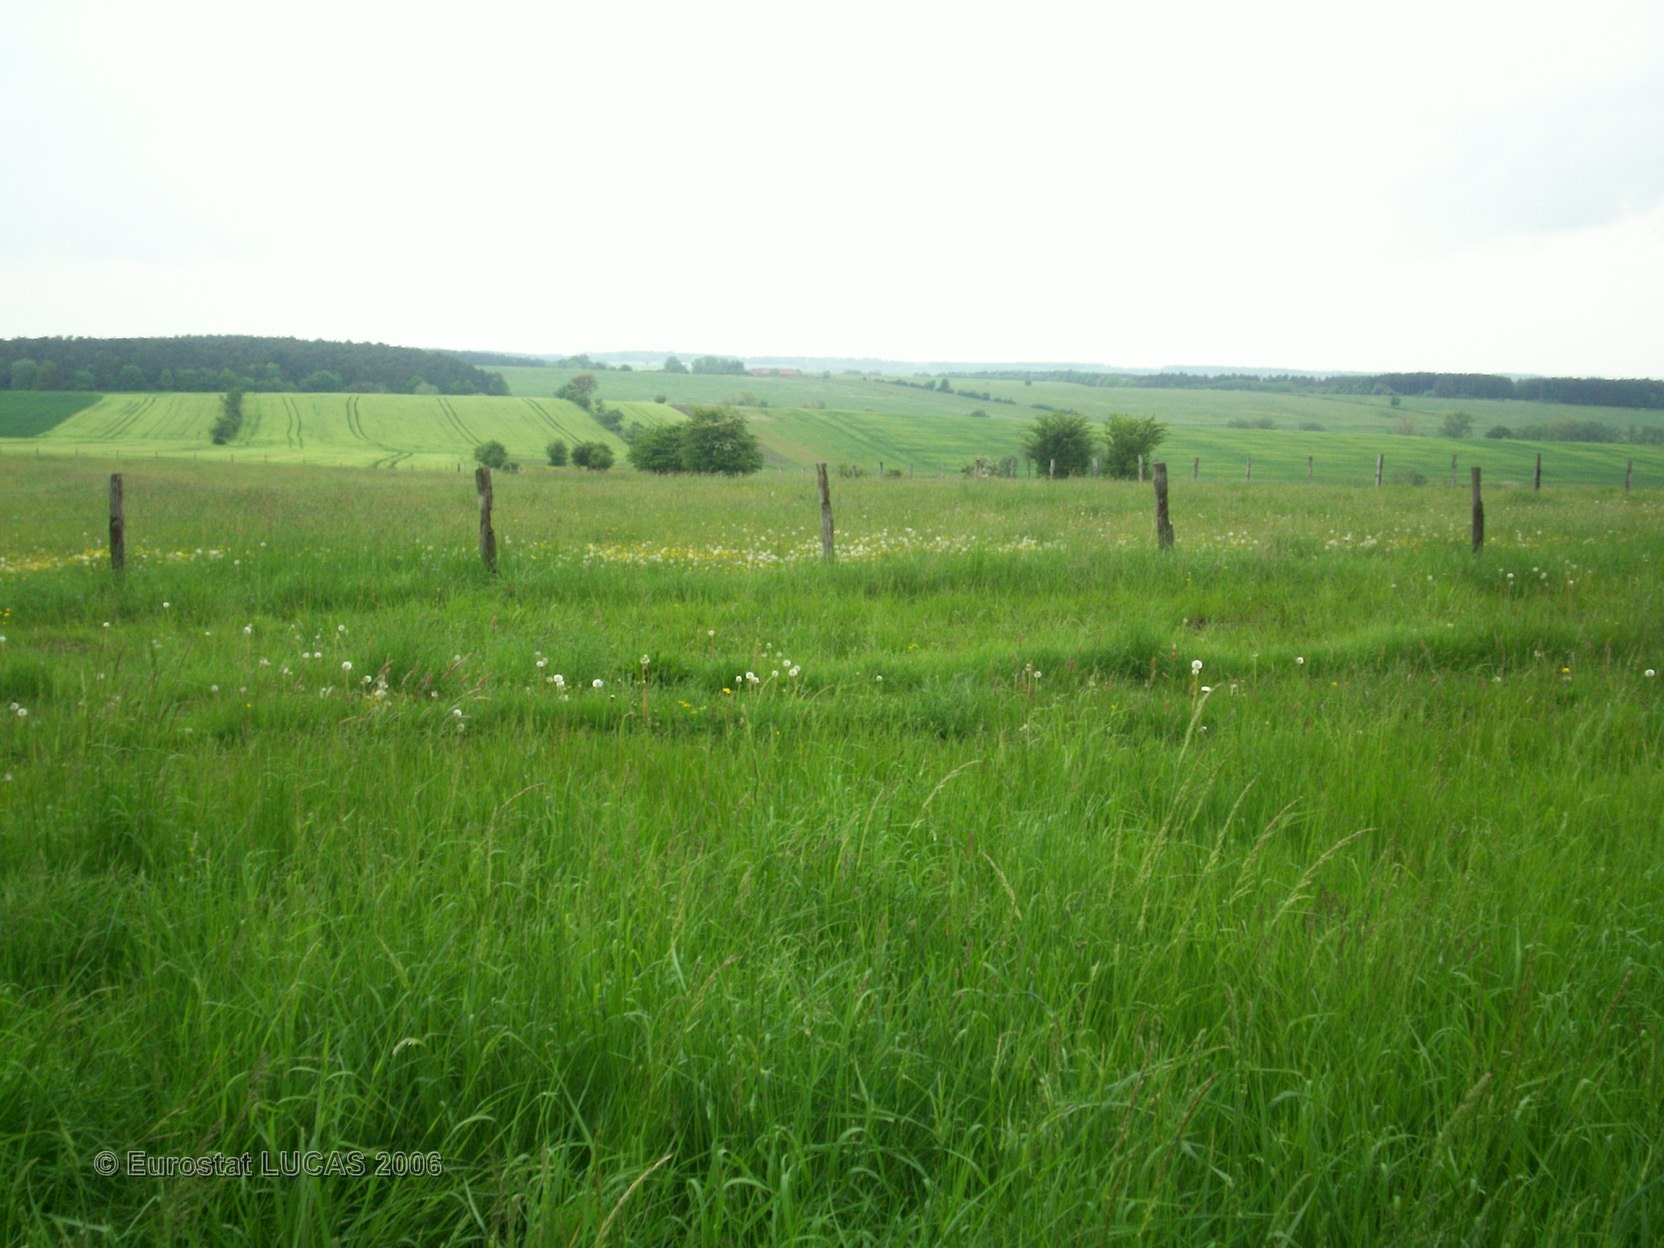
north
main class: Grassland
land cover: Grassland without tree/shrub cover
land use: Agriculture (excluding fallow land and kitchen gardens)
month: May
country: FR
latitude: 49.3365
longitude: 6.4355
